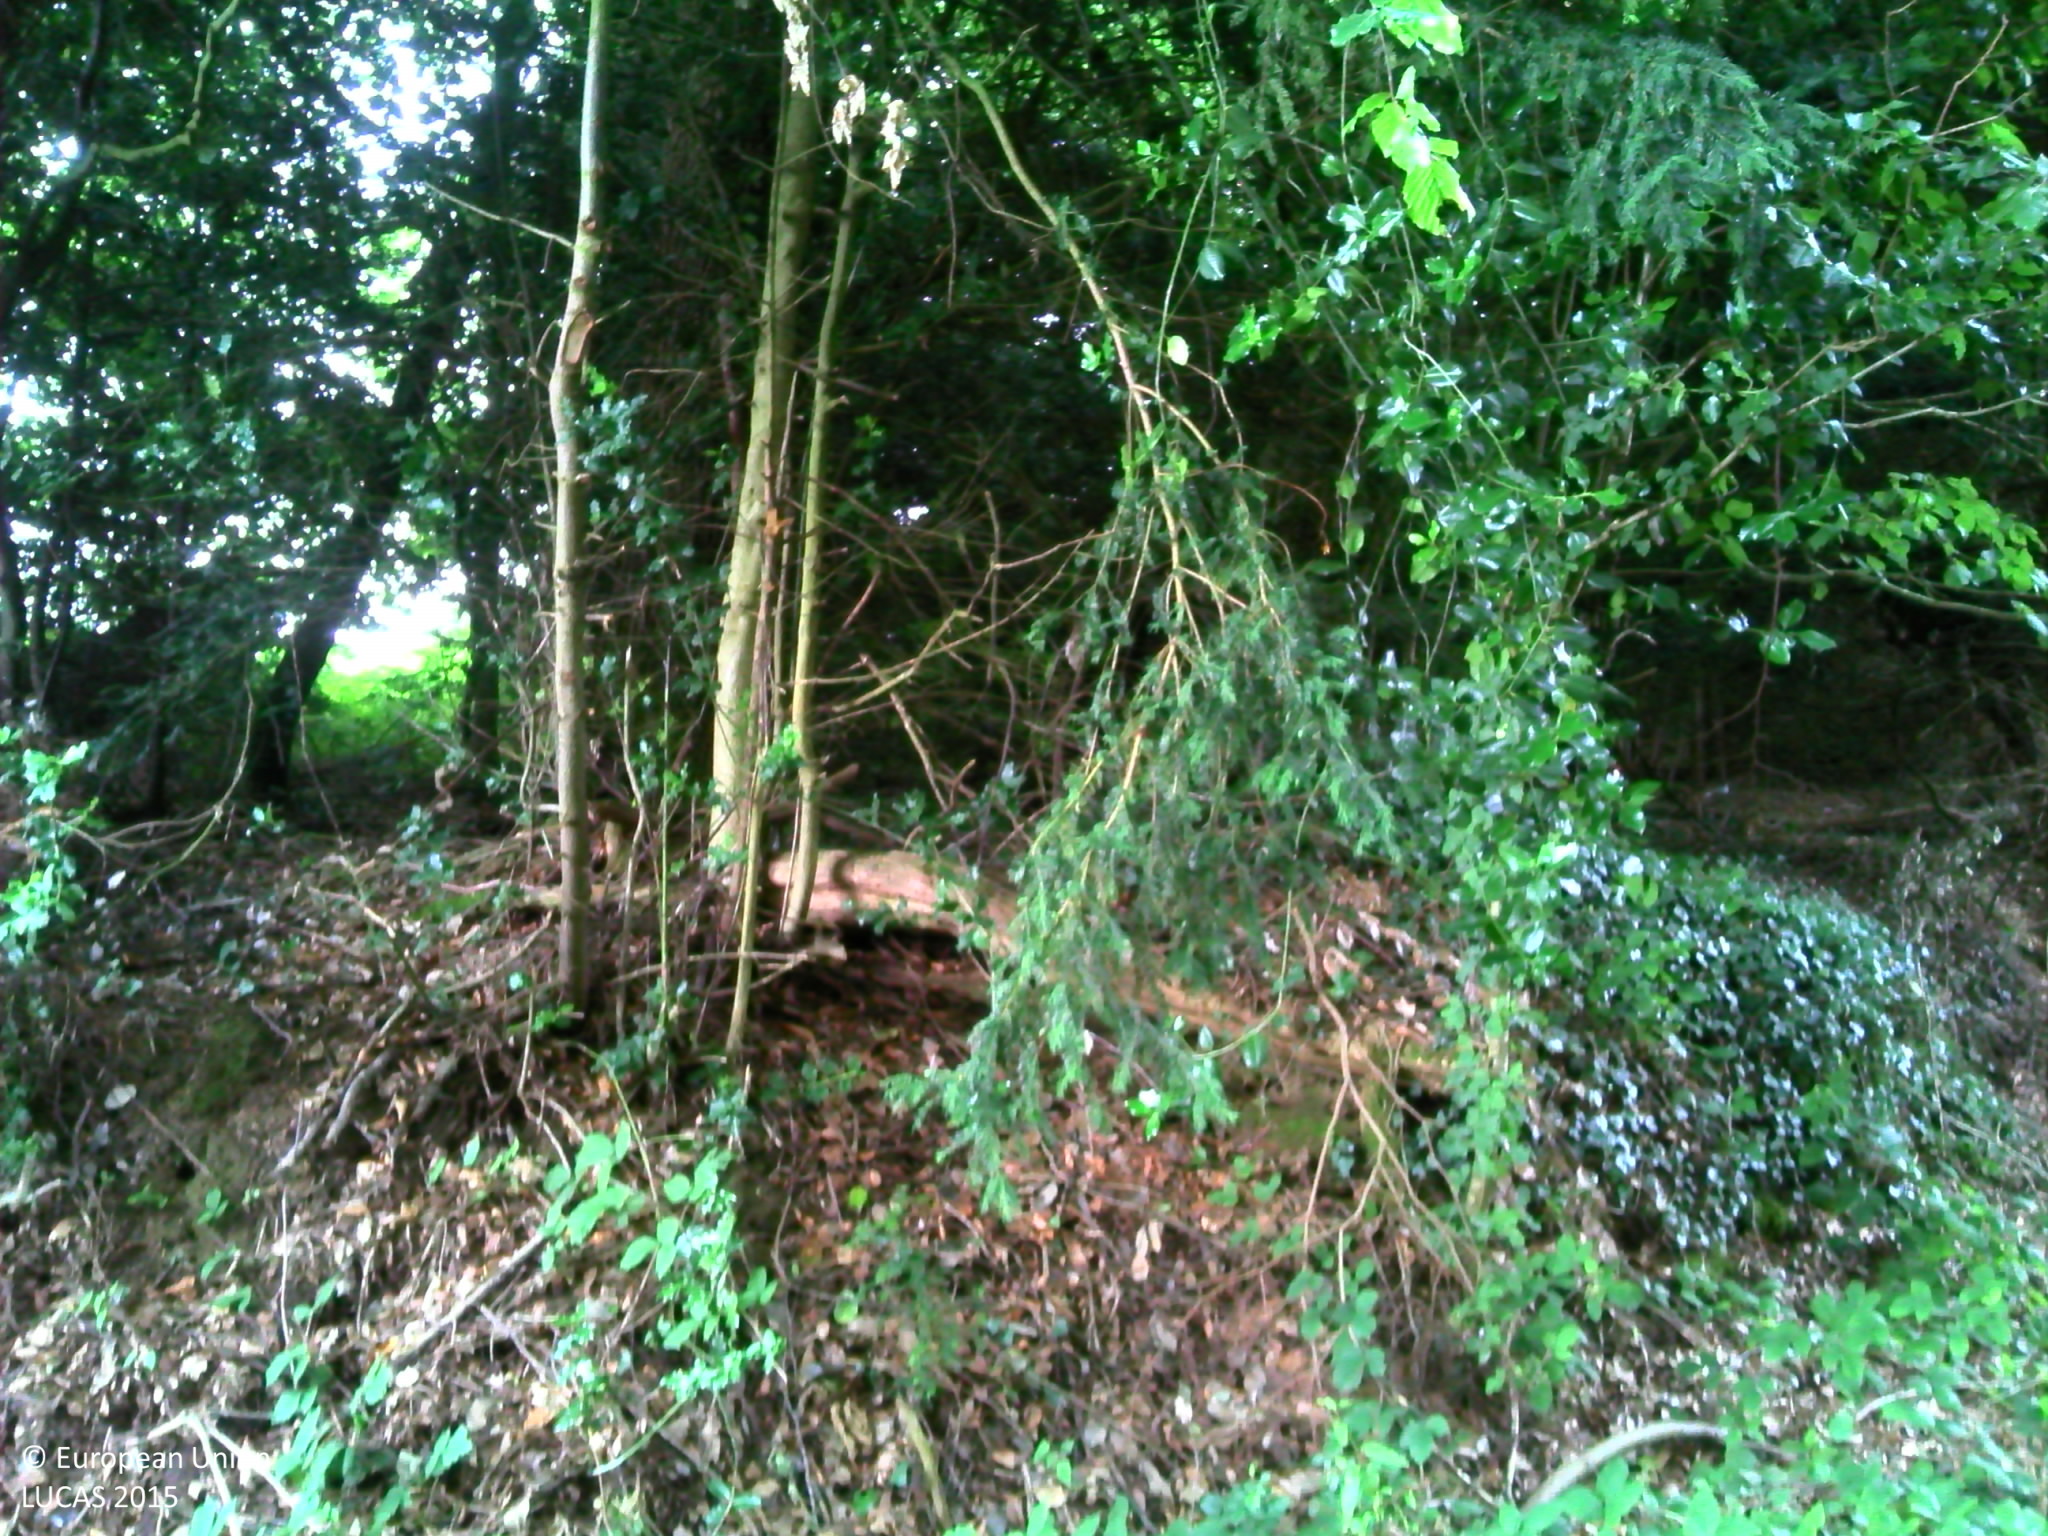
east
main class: Woodland
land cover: Broadleaved woodland
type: mesophytic deciduous forest
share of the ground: > 75 %
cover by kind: broadleaved forest trees 90 %, herbaceous plants 10 %
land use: Forestry
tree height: > 5 m
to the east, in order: Broadleaved woodland
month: July
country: FR
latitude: 48.2199
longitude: -3.1133
